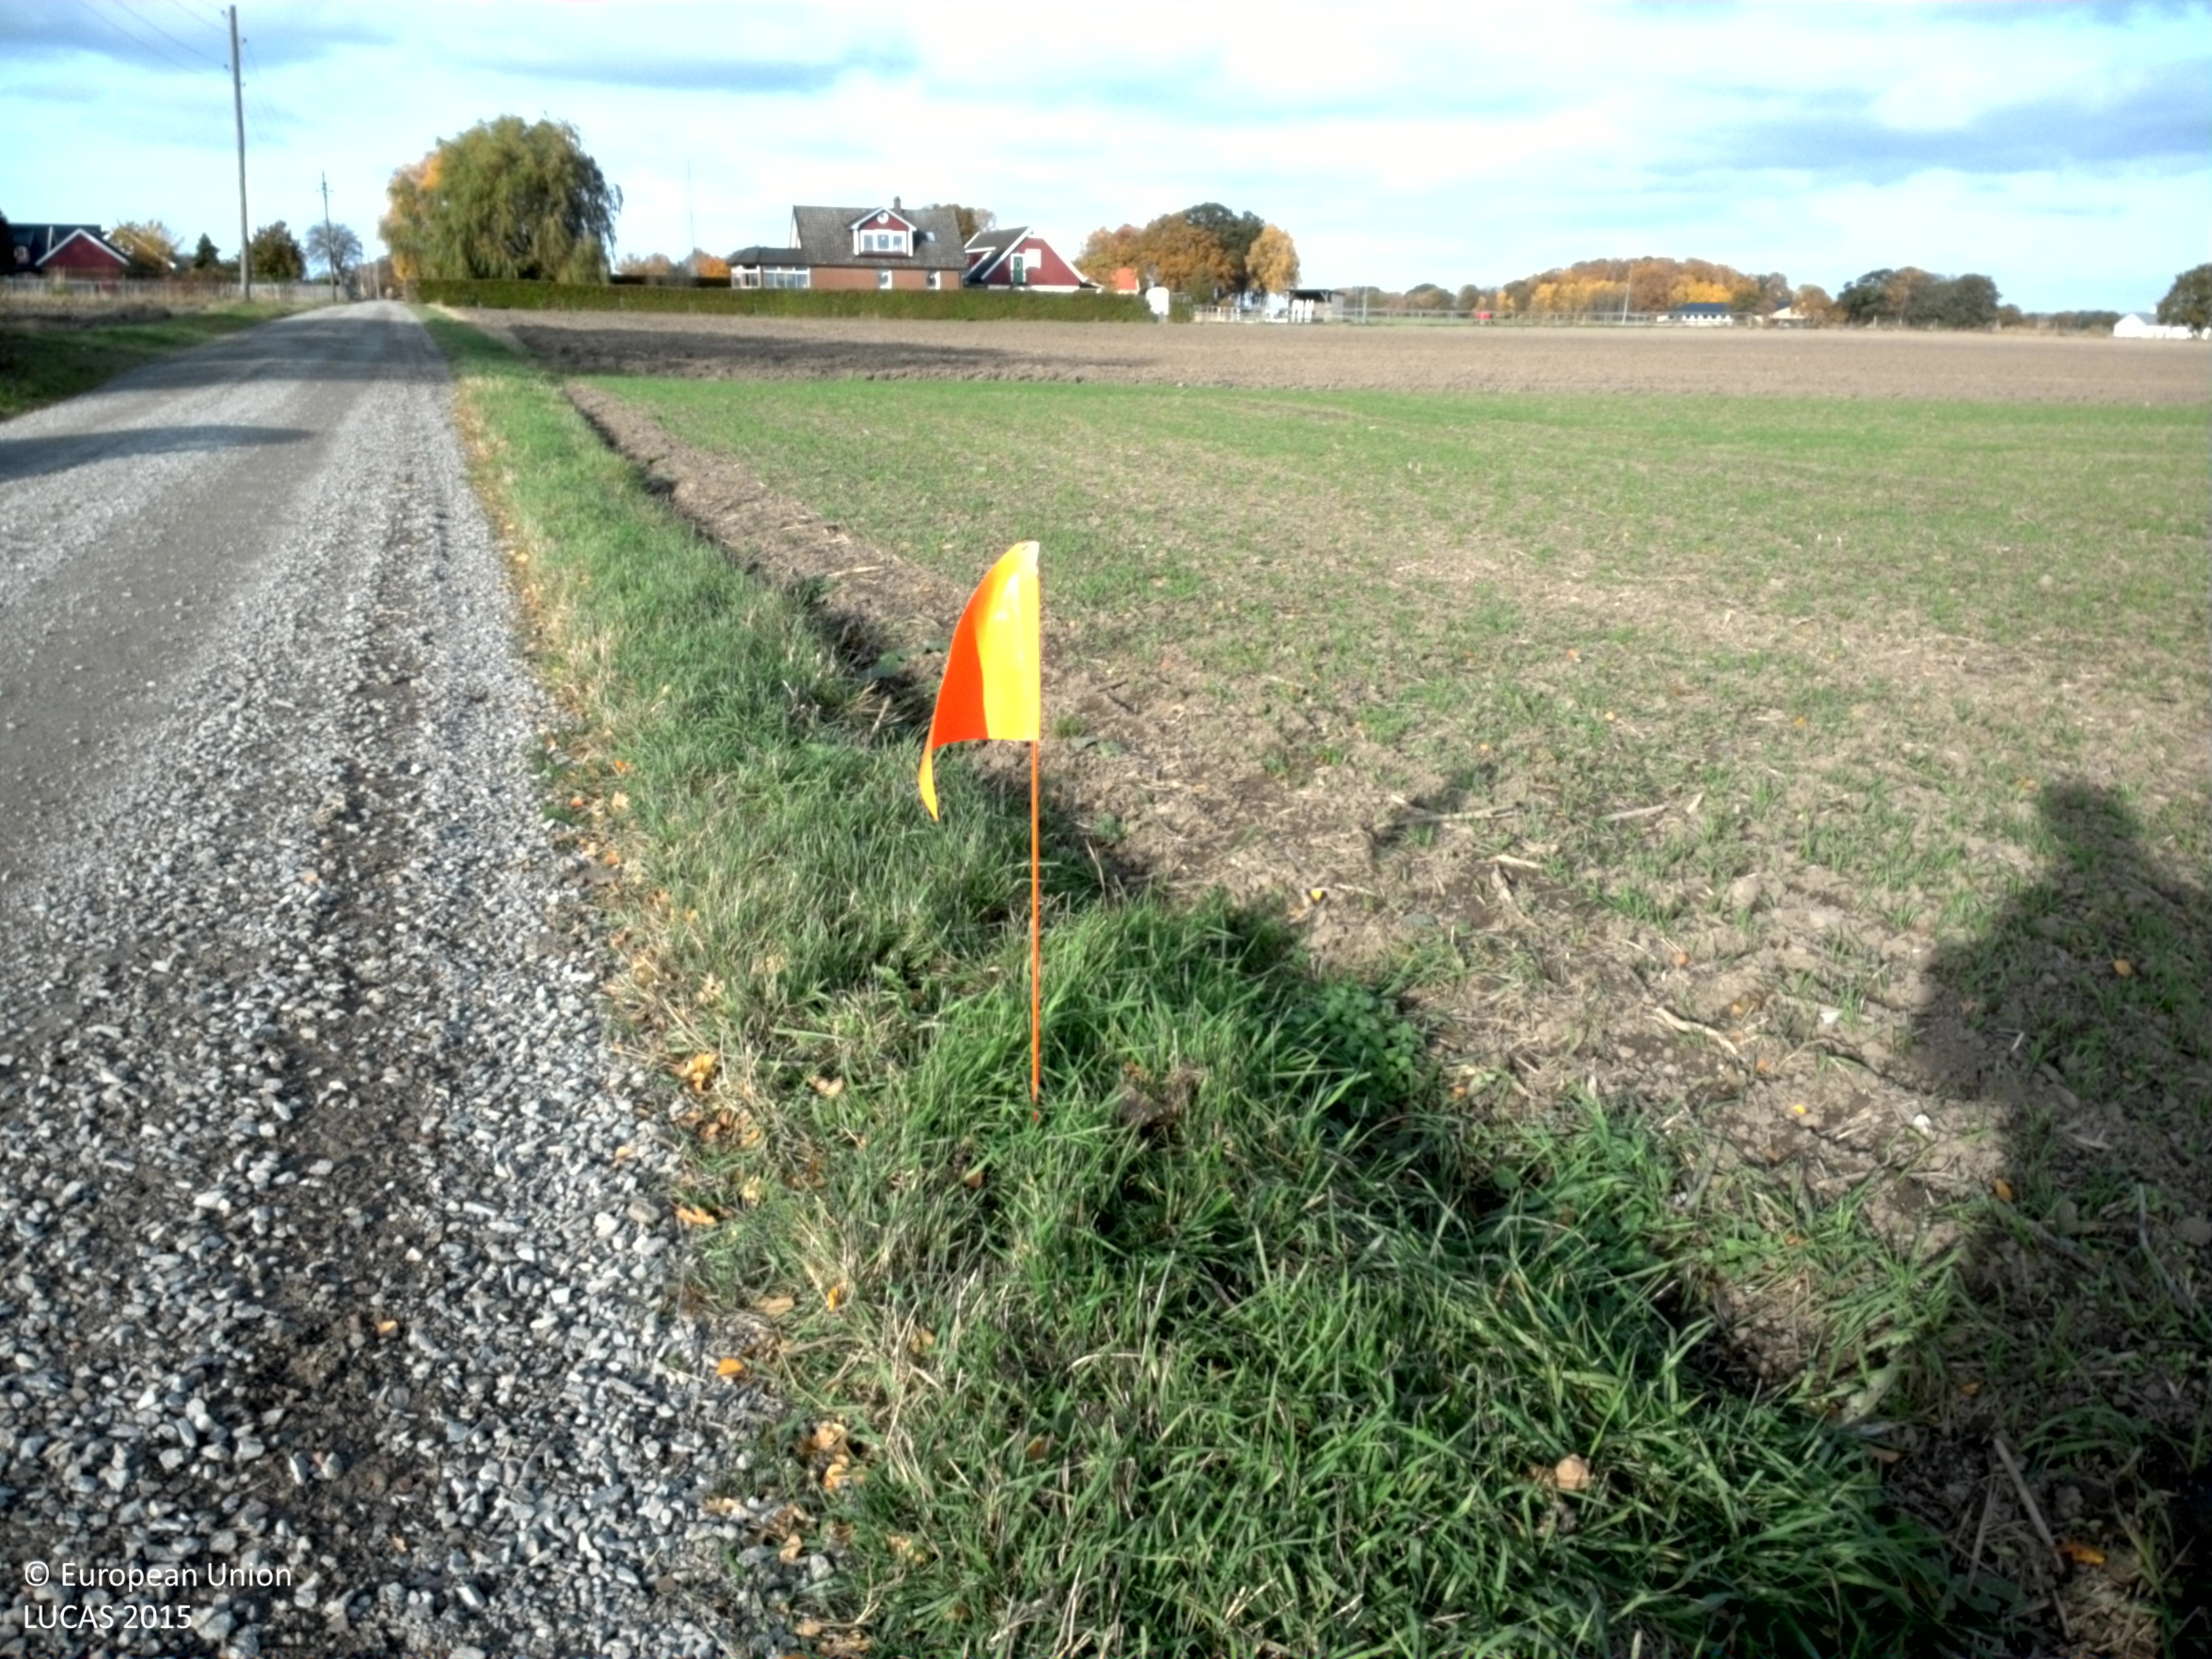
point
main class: Cropland
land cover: Common wheat
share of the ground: < 10 %
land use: Agriculture (excluding fallow land and kitchen gardens)
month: October
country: SE
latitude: 56.0305
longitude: 12.8380
